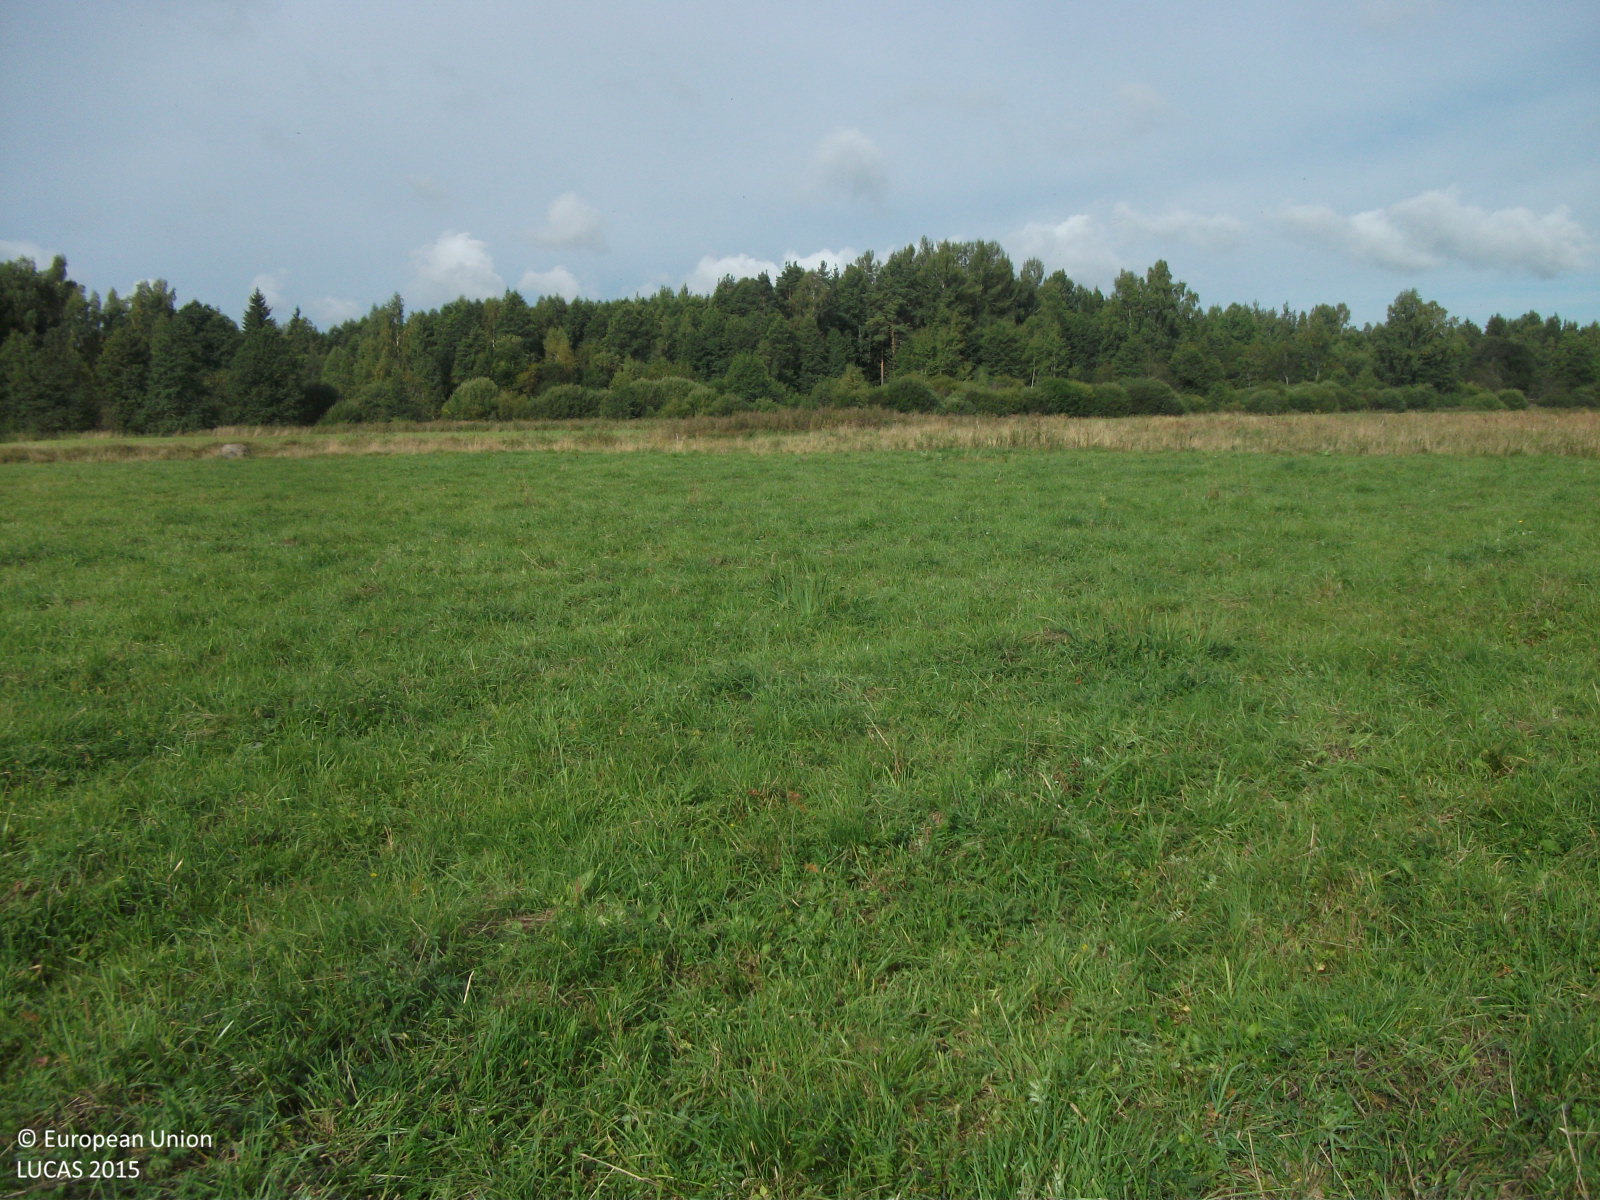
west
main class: Grassland
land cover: Grassland without tree/shrub cover
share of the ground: > 75 %
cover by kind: herbaceous plants 100 %
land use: Agriculture (excluding fallow land and kitchen gardens)
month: September
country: LV
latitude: 56.5425
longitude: 26.2243
